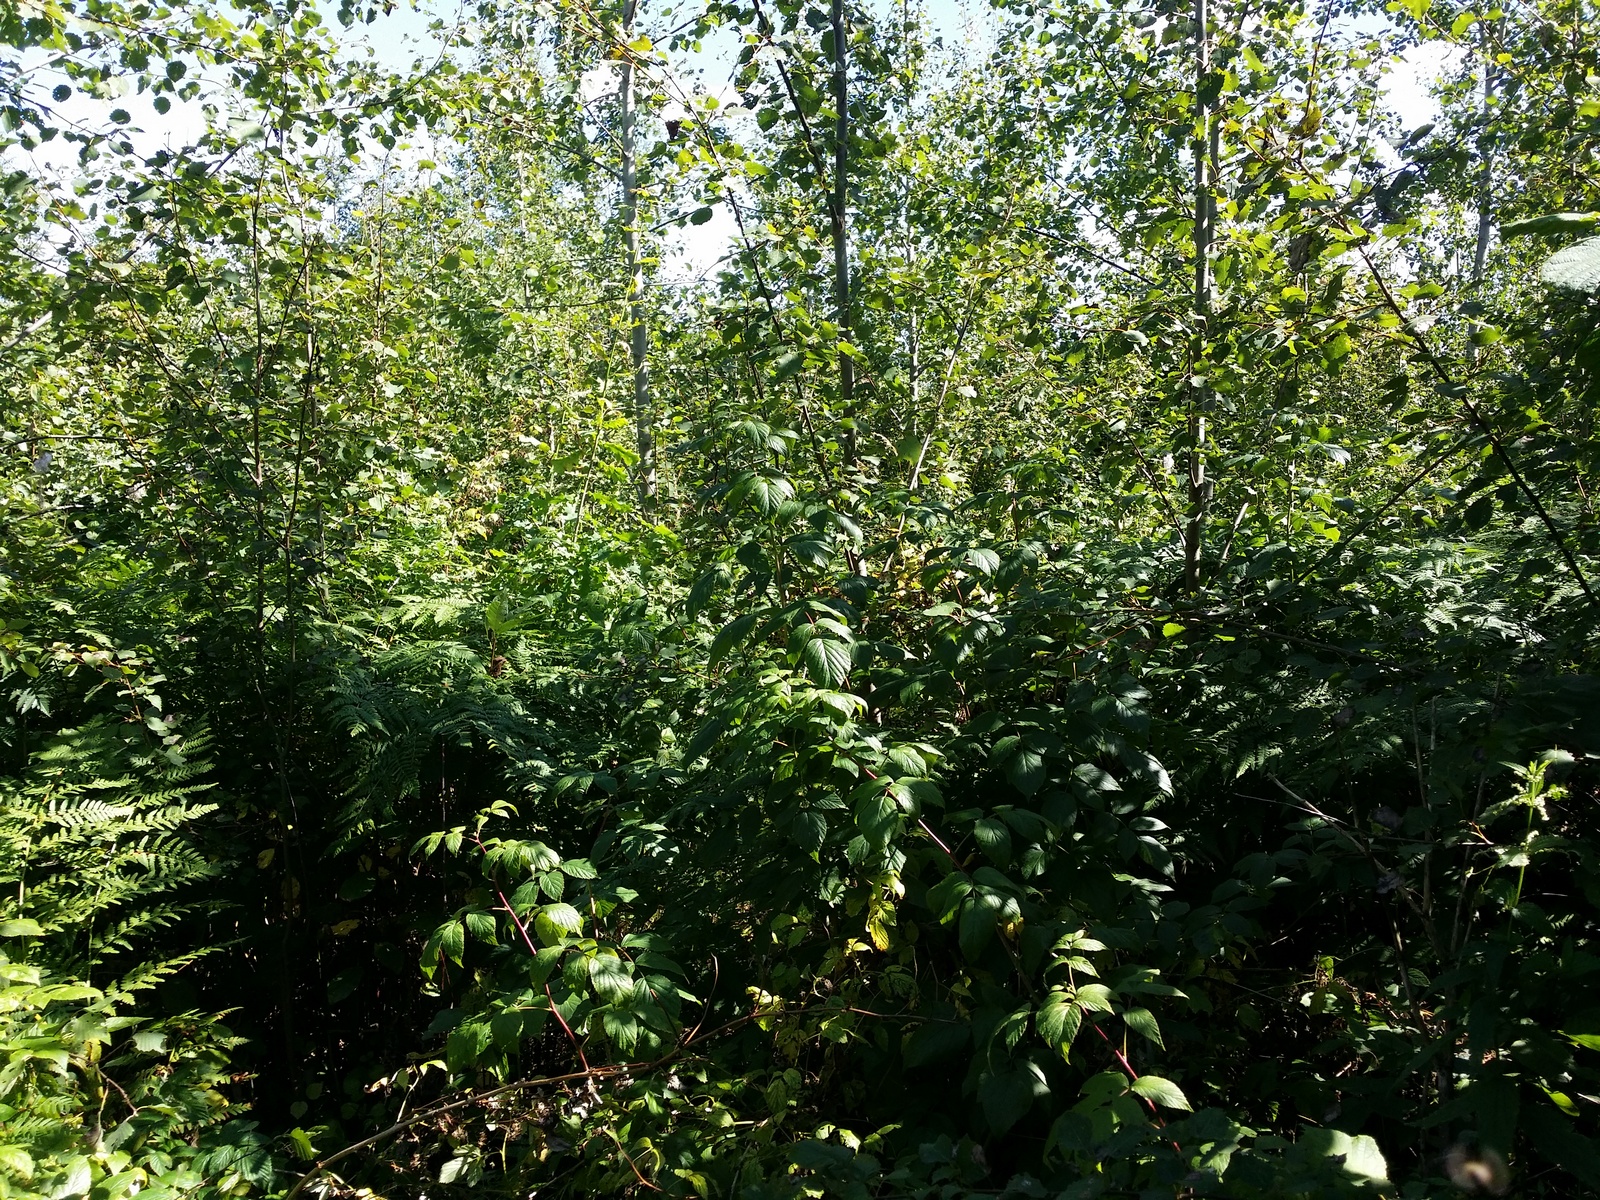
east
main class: Woodland
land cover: Broadleaved woodland
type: non-riverine alder, birch or aspen forest
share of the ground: > 75 %
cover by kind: broadleaved forest trees 90 %, herbaceous plants 10 %
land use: Forestry
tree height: < 5 m
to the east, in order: Broadleaved woodland; Shruby margins; Common wheat; Shruby margins; Broadleaved woodland
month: August
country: LV
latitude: 57.0515
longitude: 27.6734
